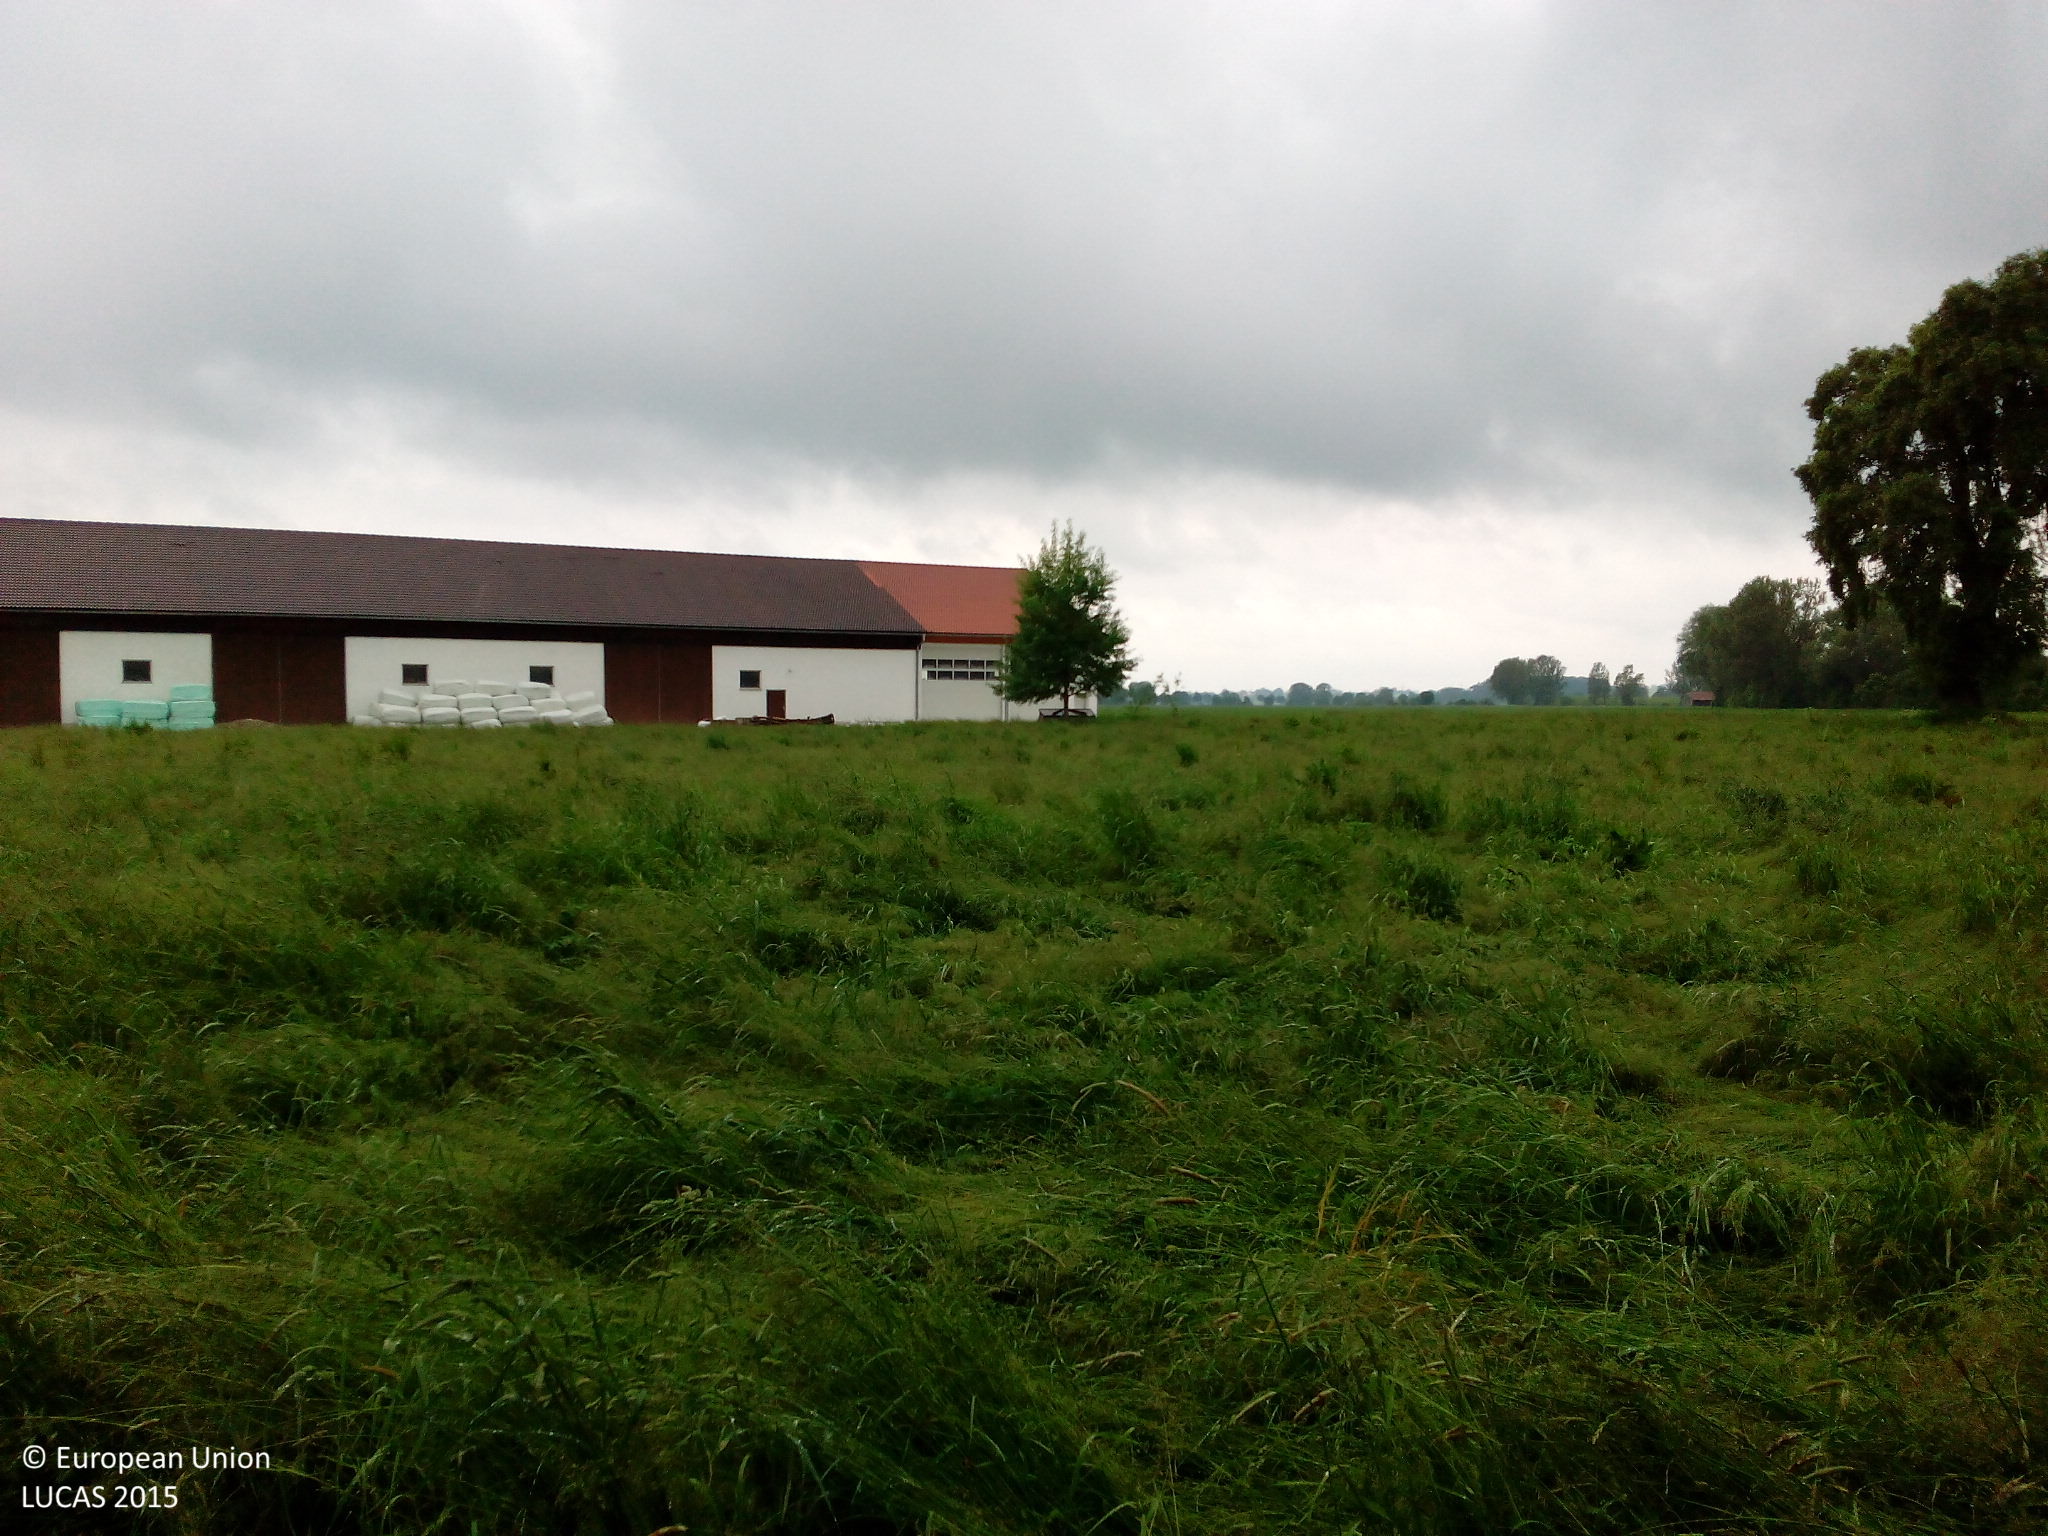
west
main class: Grassland
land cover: Grassland without tree/shrub cover
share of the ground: > 75 %
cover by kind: herbaceous plants 100 %
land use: Agriculture (excluding fallow land and kitchen gardens)
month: May
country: DE
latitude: 48.2512
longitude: 11.3595
